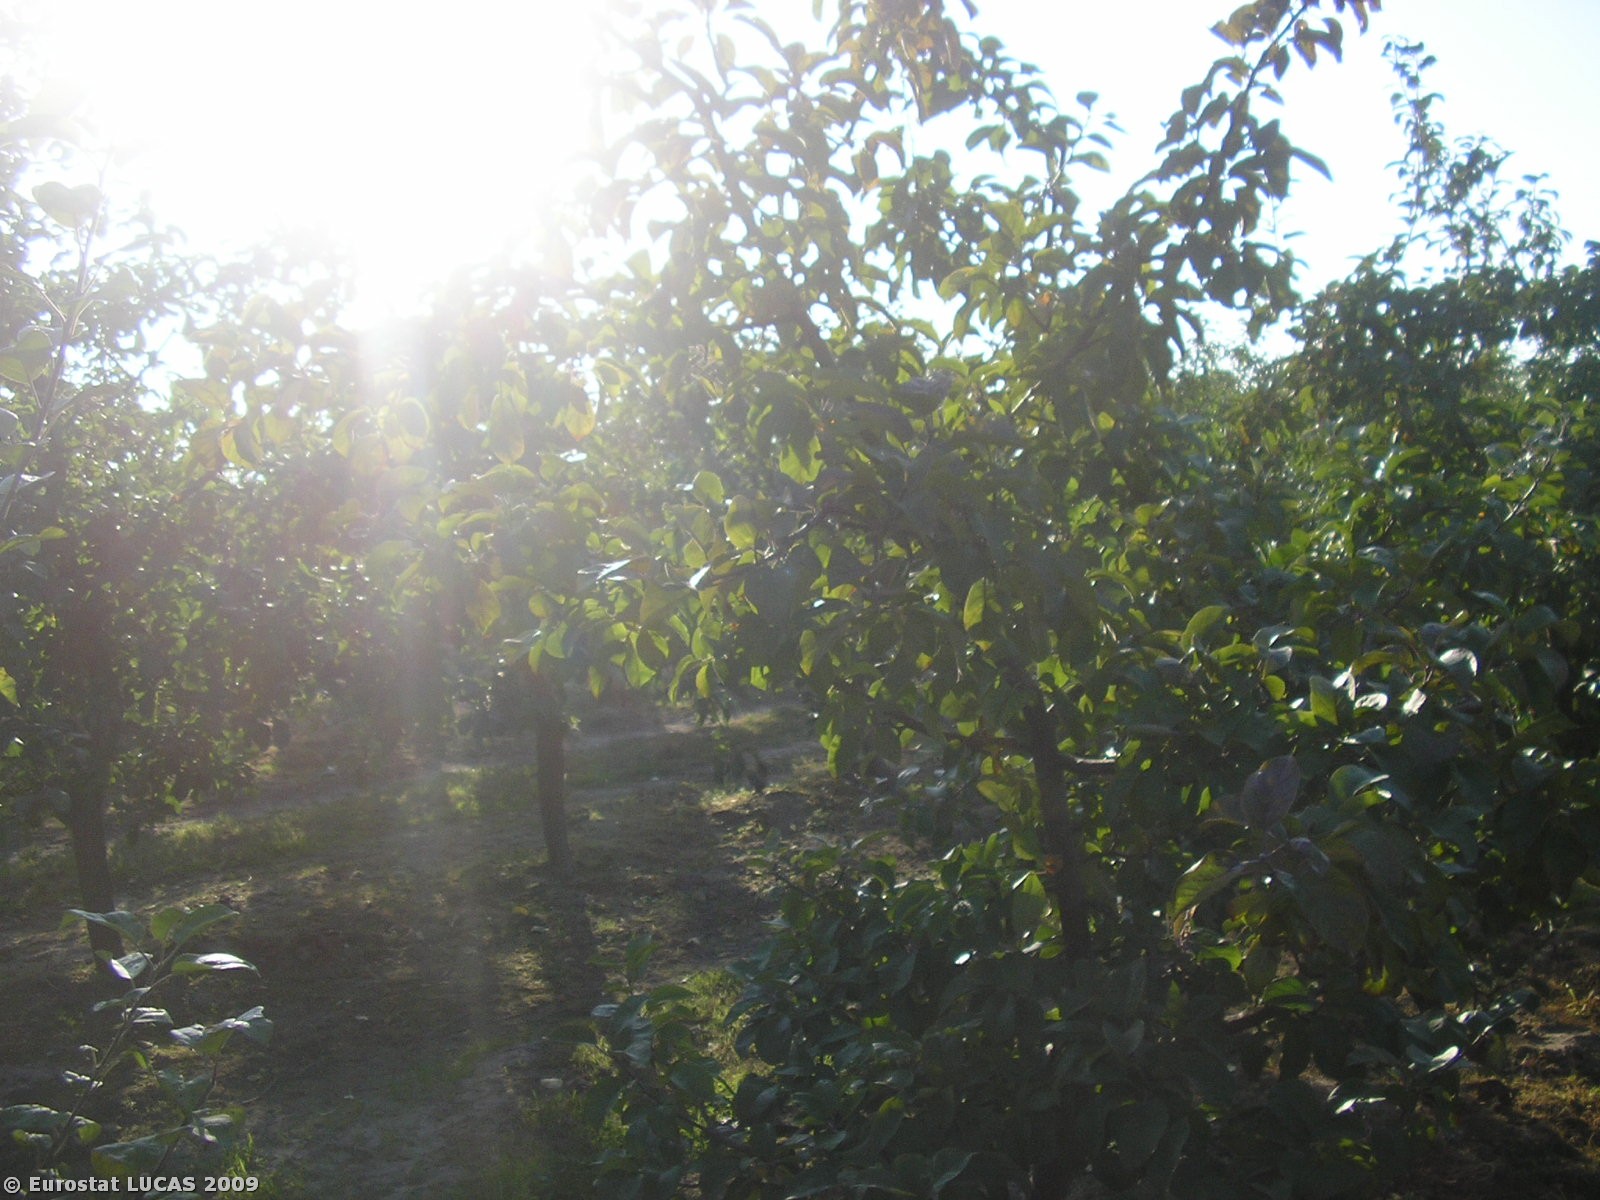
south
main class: Cropland
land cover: Apple fruit
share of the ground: 25 - 50 %
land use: Agriculture (excluding fallow land and kitchen gardens)
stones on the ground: < 10 %
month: September
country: PL
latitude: 51.8168
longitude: 20.7325
